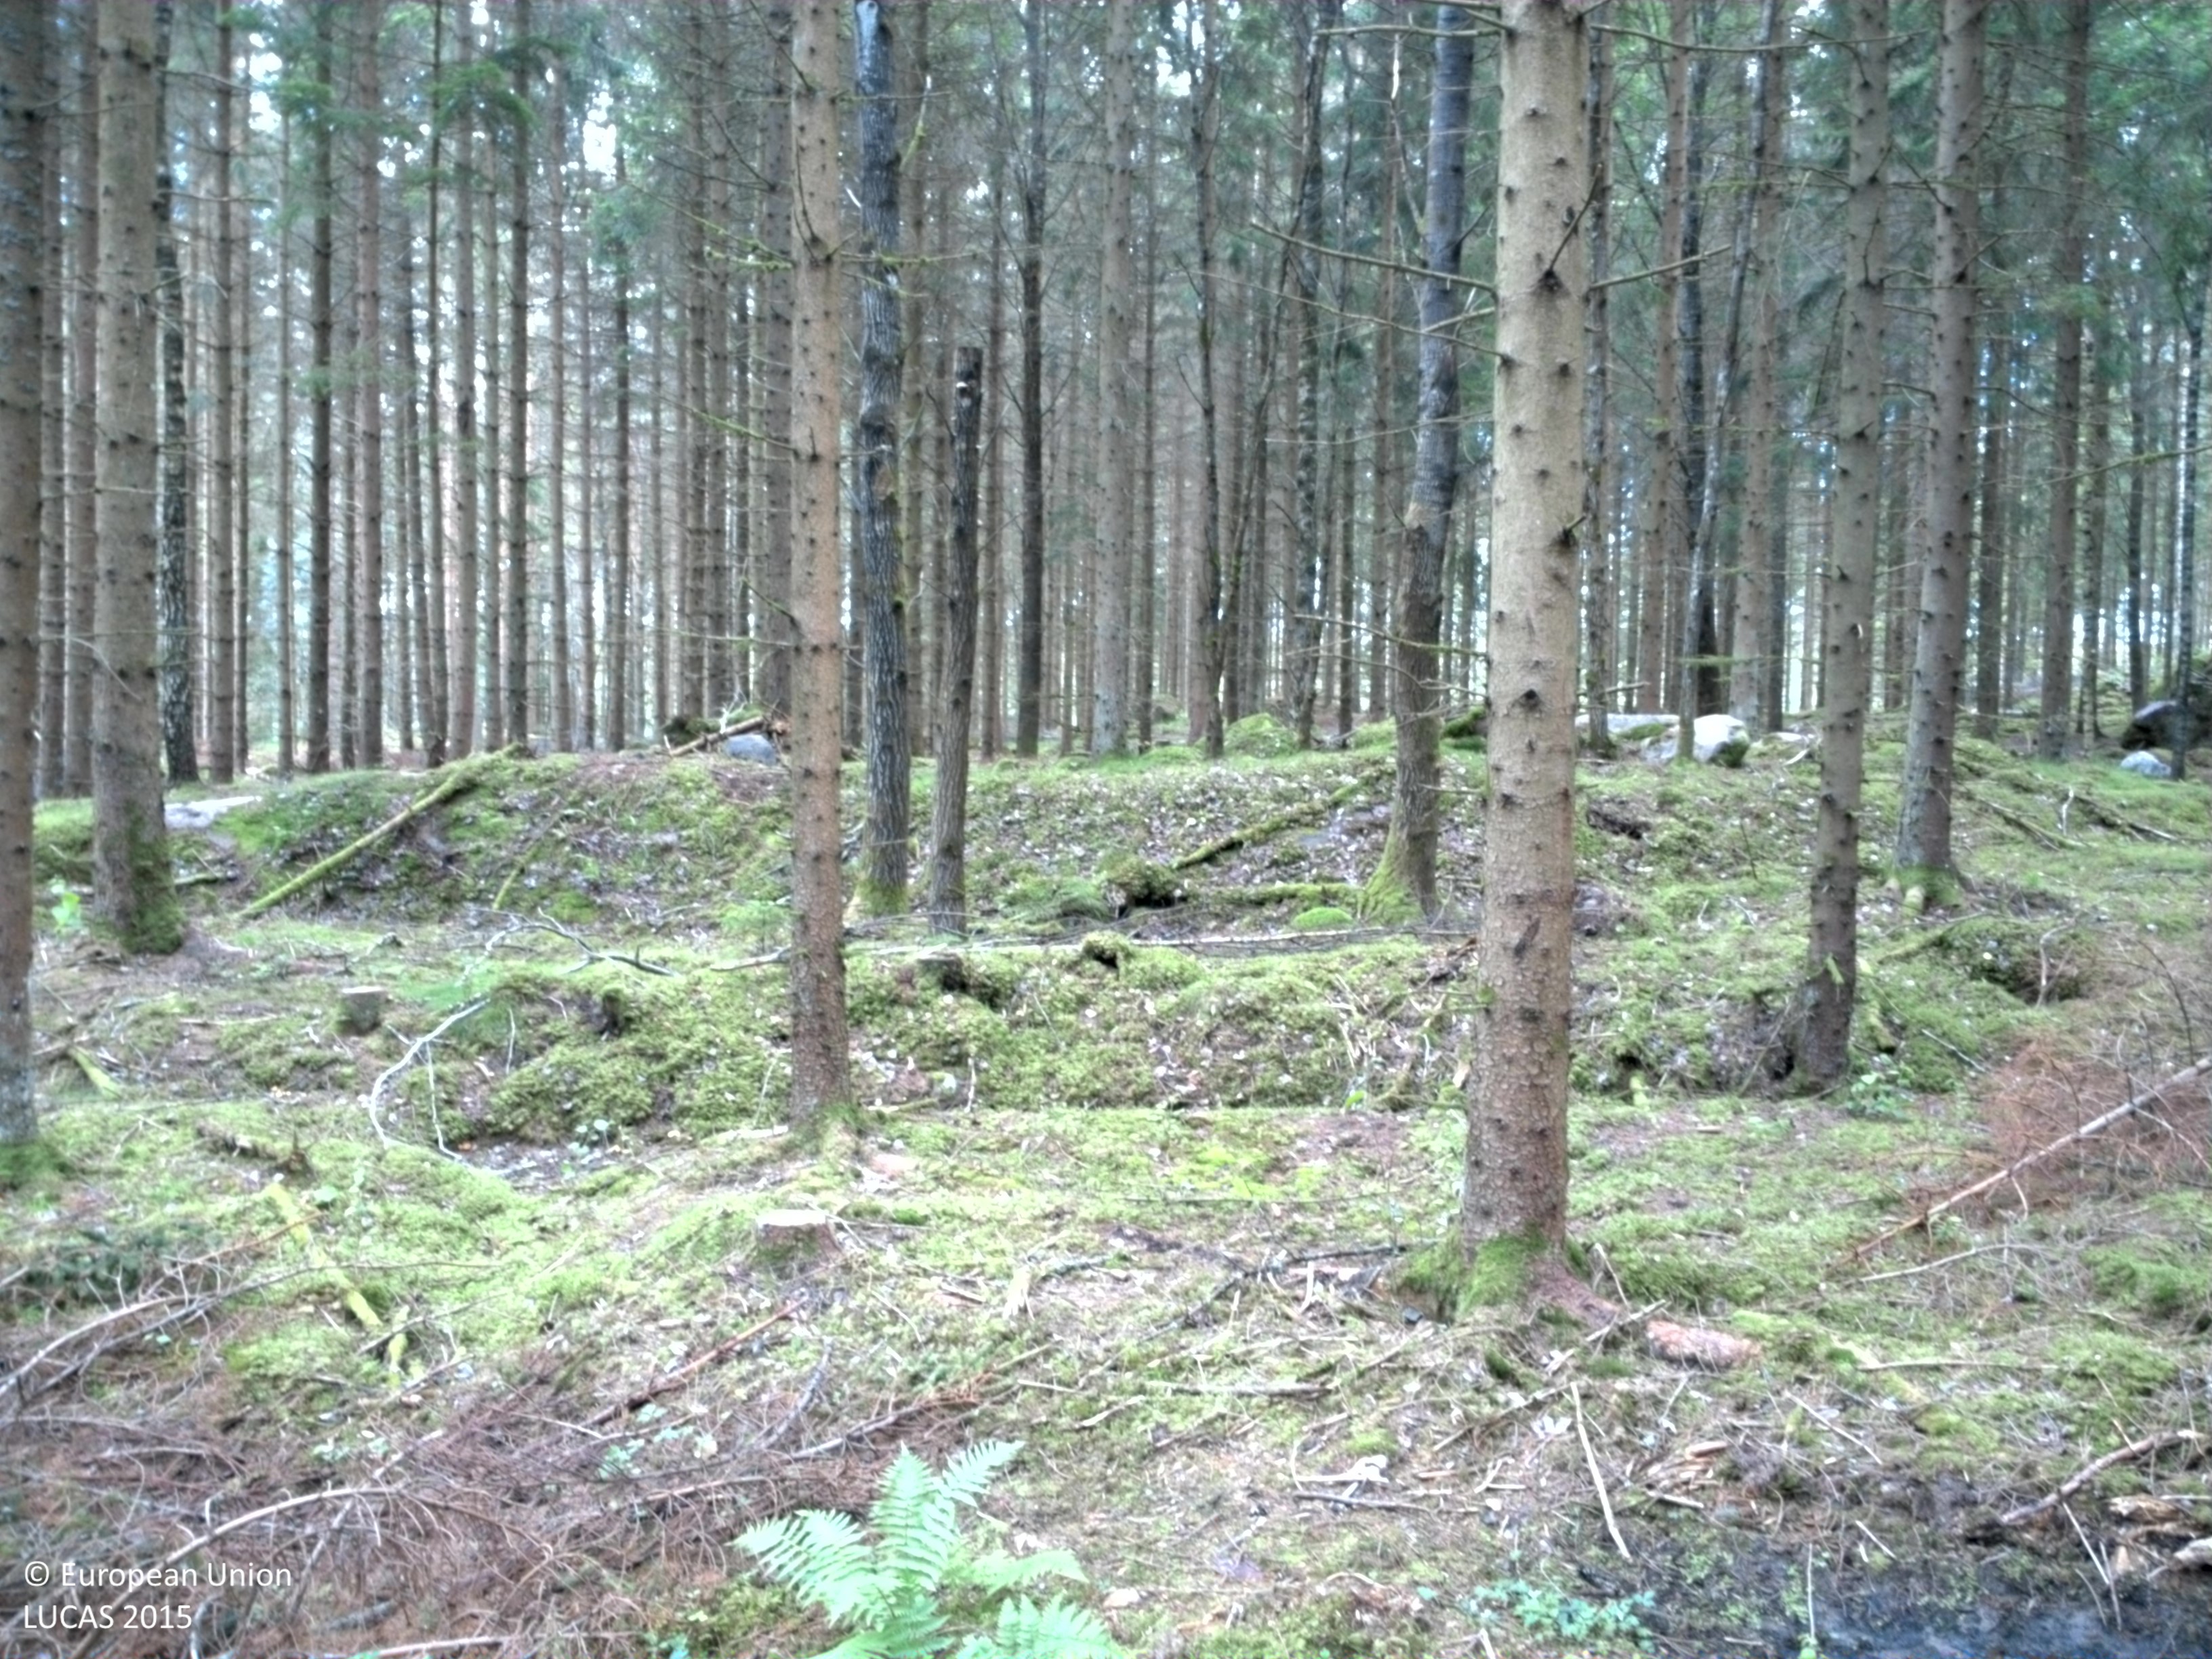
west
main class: Woodland
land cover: Spruce dominated coniferous woodland
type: boreal forest
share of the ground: 50 - 75 %
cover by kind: coniferous forest trees 75 %, lichens and mosses 10 %, unconsolidated bare surface 10 %, herbaceous plants 5 %
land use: Forestry
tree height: > 5 m
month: July
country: SE
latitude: 58.7180
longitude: 14.0161
